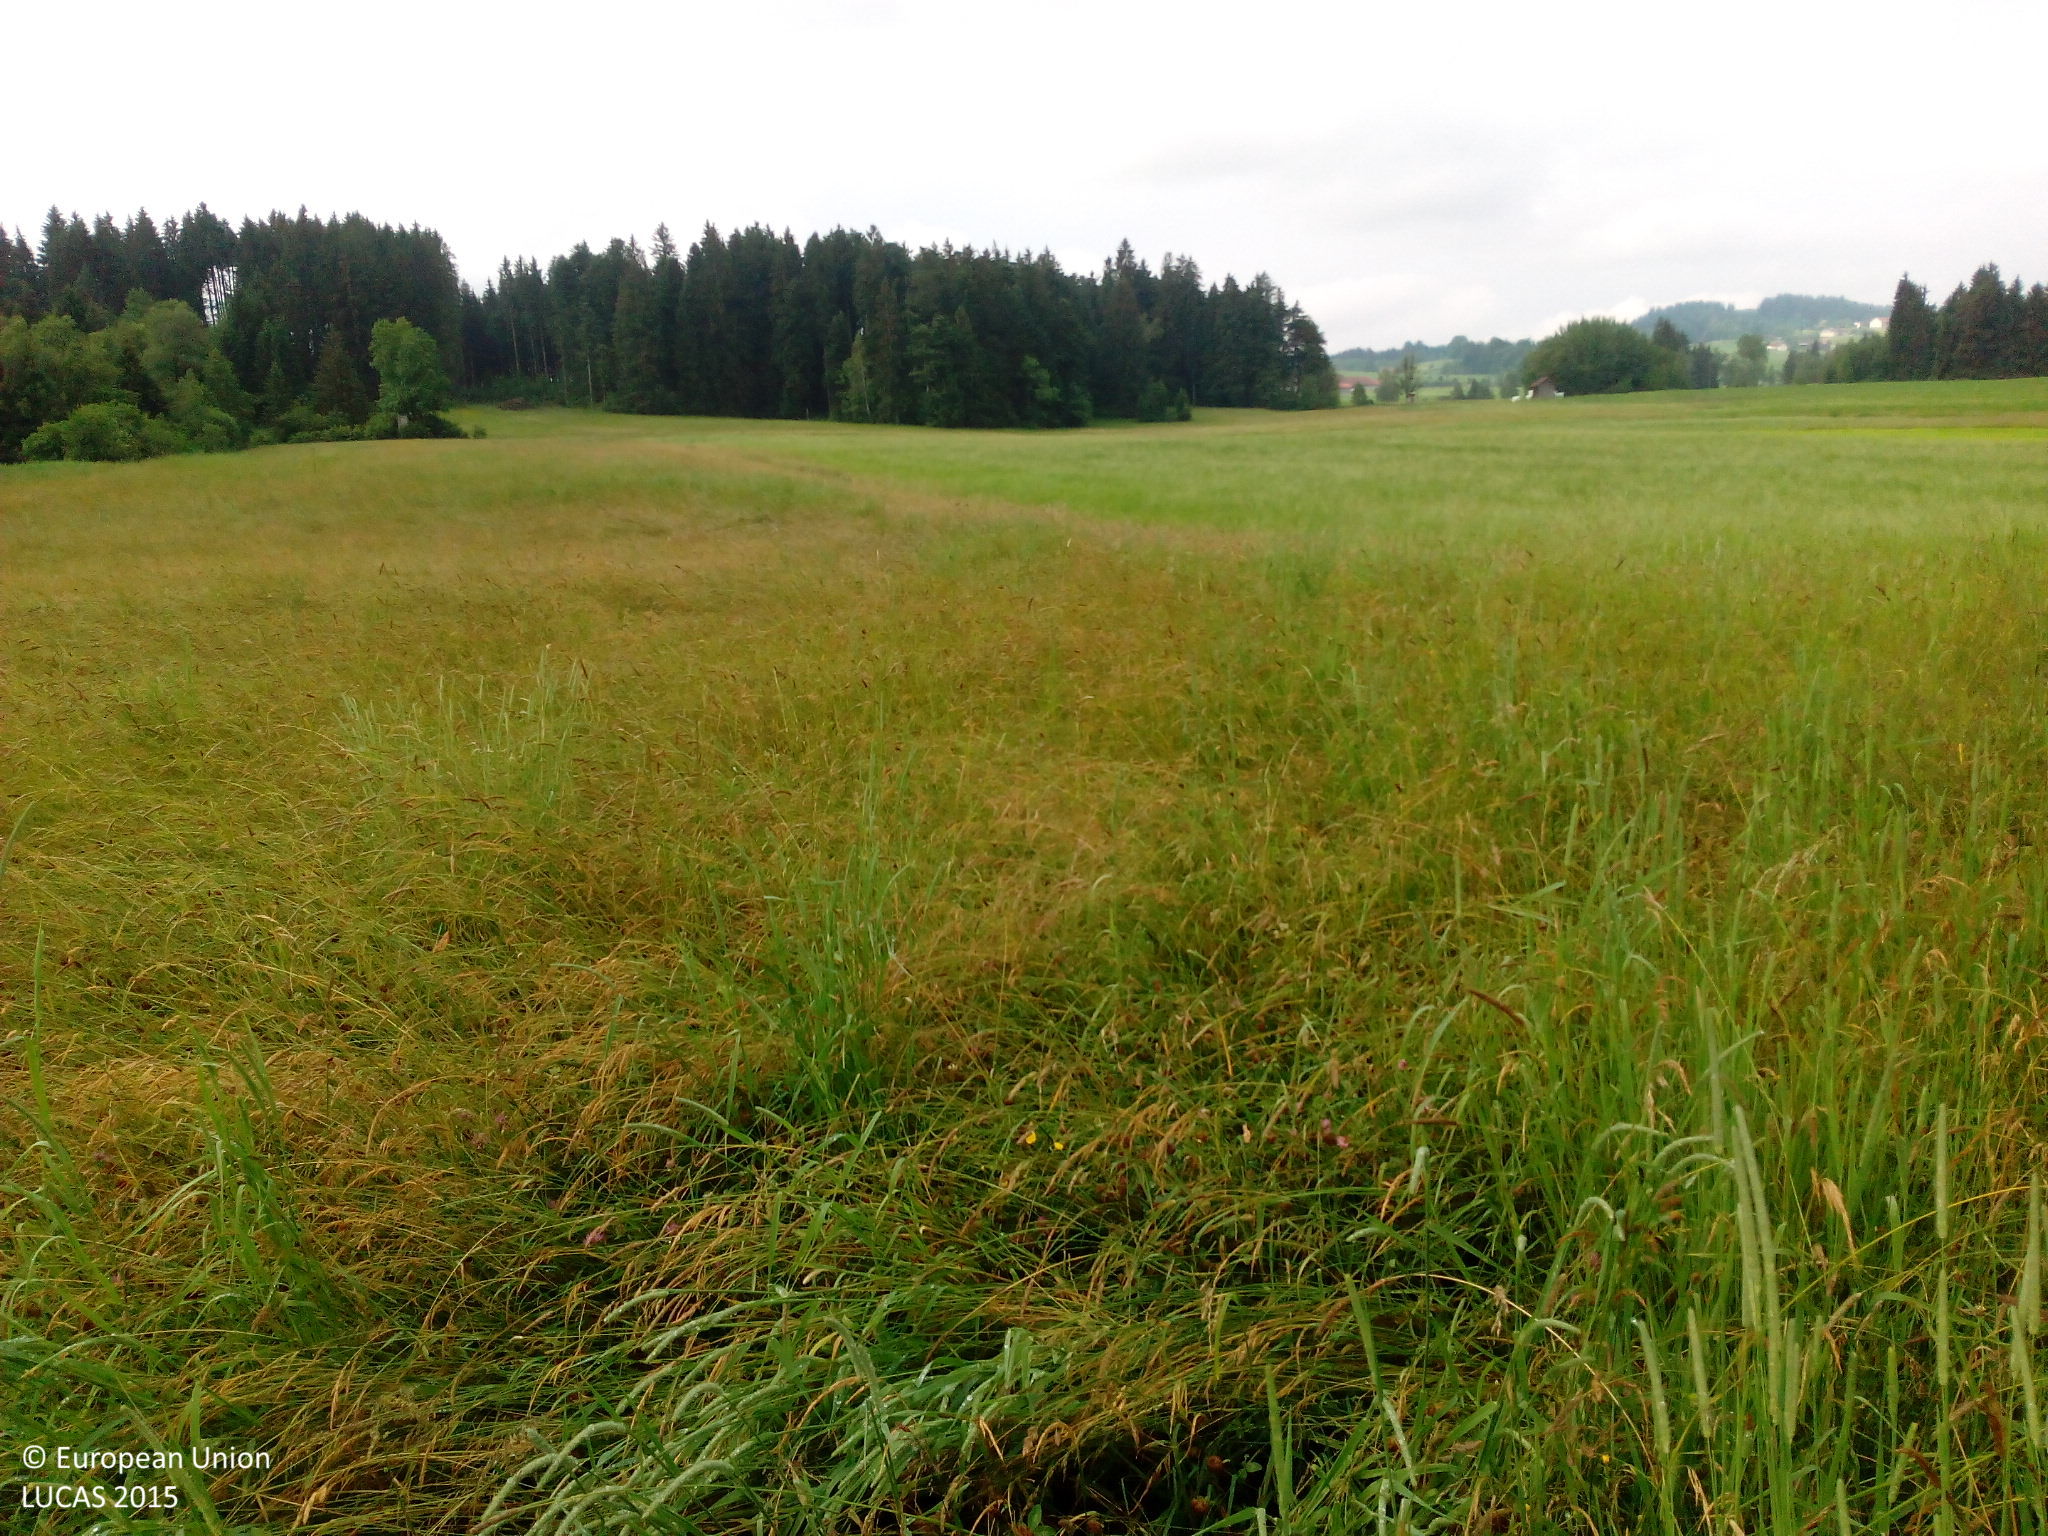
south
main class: Grassland
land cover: Grassland without tree/shrub cover
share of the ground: > 75 %
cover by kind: herbaceous plants 100 %
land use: Agriculture (excluding fallow land and kitchen gardens)
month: June
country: DE
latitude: 47.6296
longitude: 9.9335
